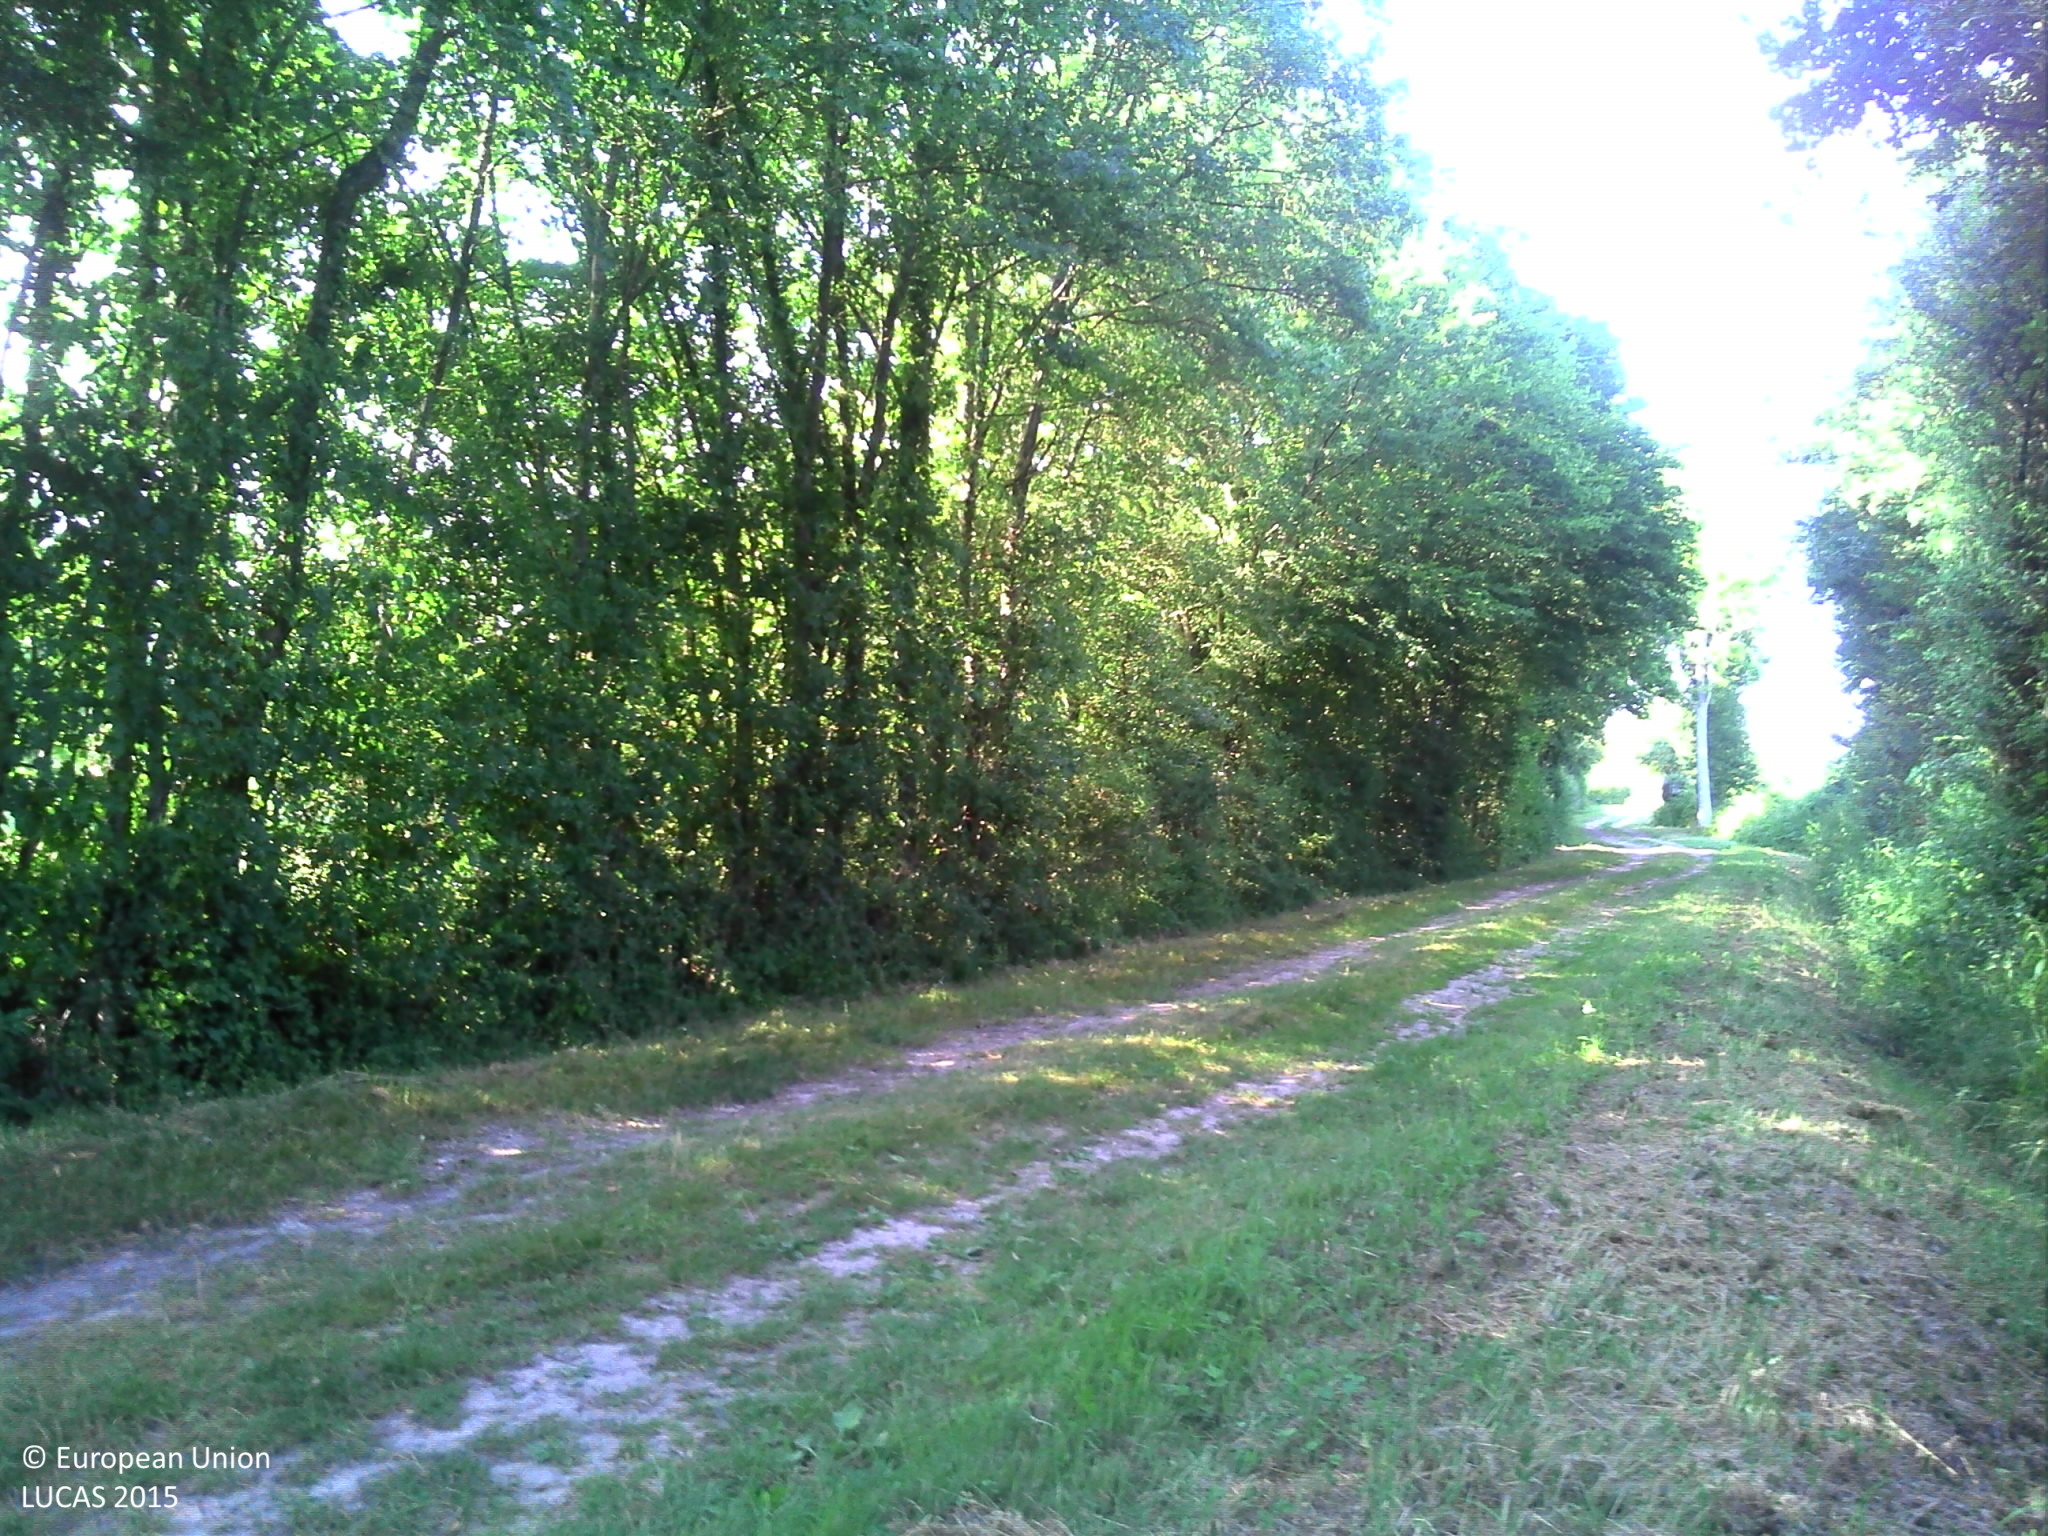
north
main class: Cropland
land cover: Sunflower
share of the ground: 25 - 50 %
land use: Agriculture (excluding fallow land and kitchen gardens)
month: June
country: FR
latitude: 47.6335
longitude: 2.6324
